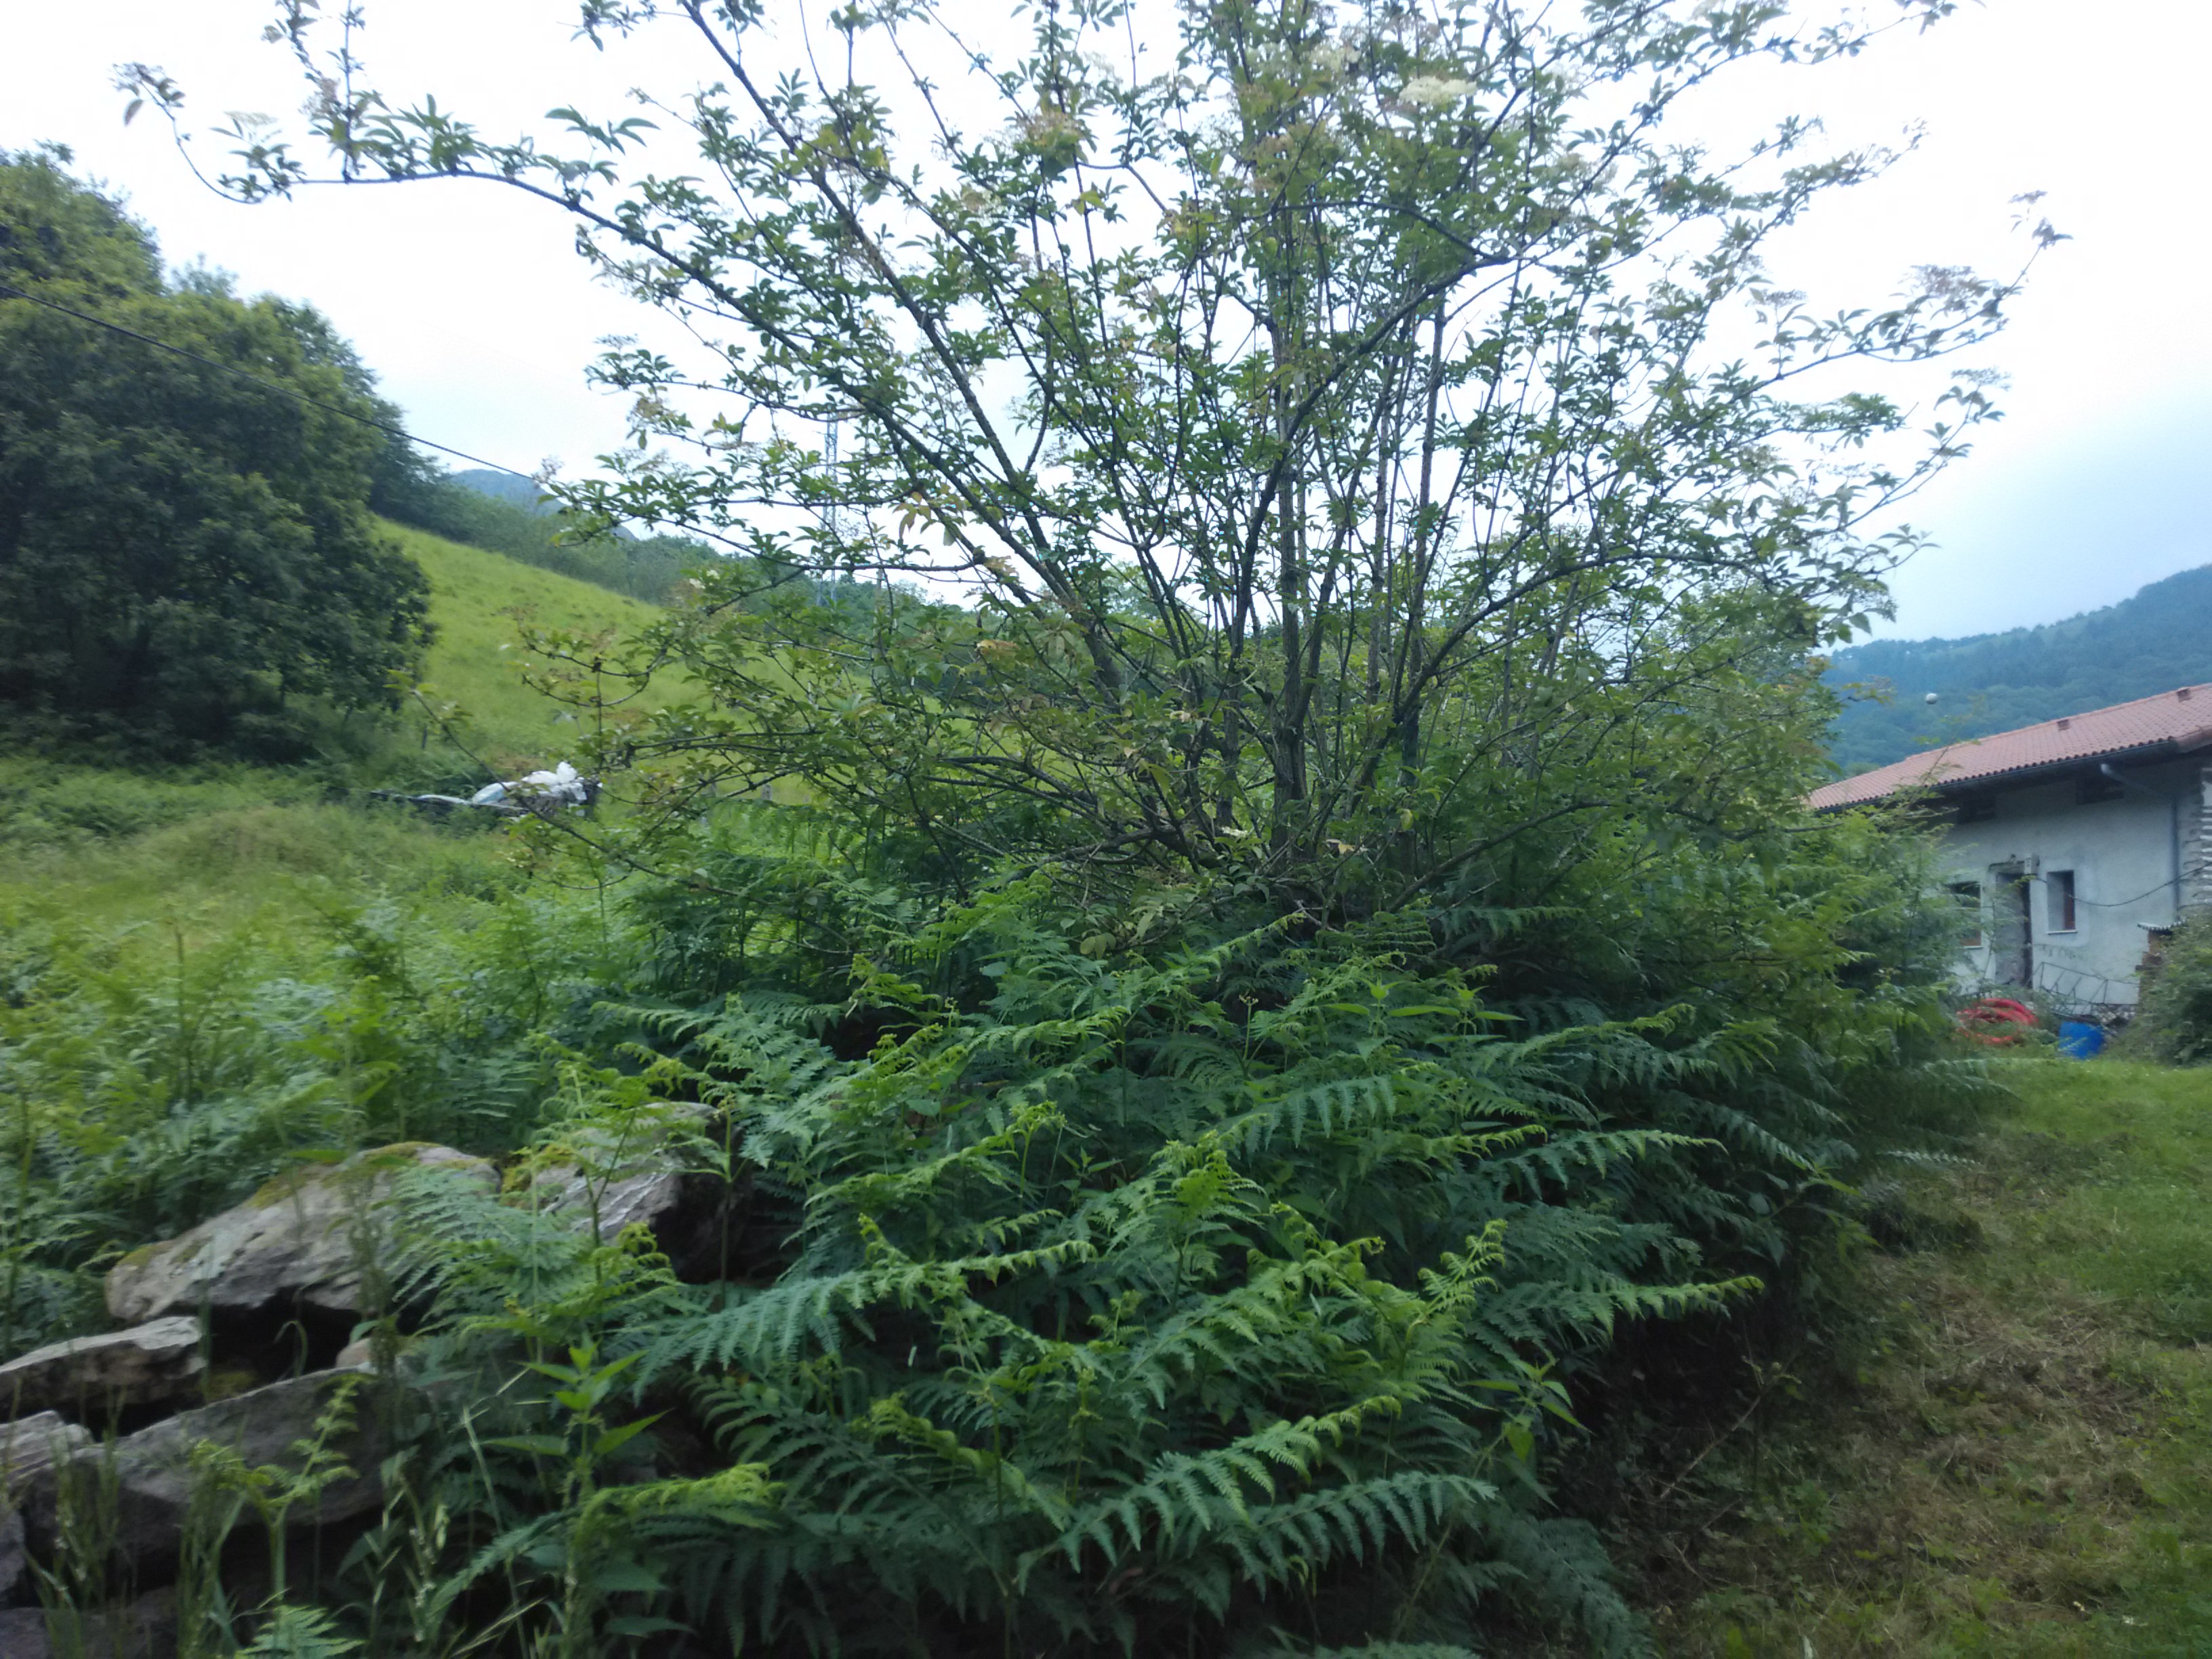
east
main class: Grassland
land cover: Grassland without tree/shrub cover
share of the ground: > 75 %
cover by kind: herbaceous plants 85 %, consolidated bare surface 10 %, shrubs 5 %
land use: Agriculture (excluding fallow land and kitchen gardens)
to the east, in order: Grassland without tree/shrub cover; Broadleaved woodland; Fences; Grassland without tree/shrub cover; Fences; Electric lines; Broadleaved woodland; Artificial constructions in urban areas; Grassland without tree/shrub cover; Broadleaved woodland
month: June
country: ES
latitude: 43.2726
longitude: -1.8117
